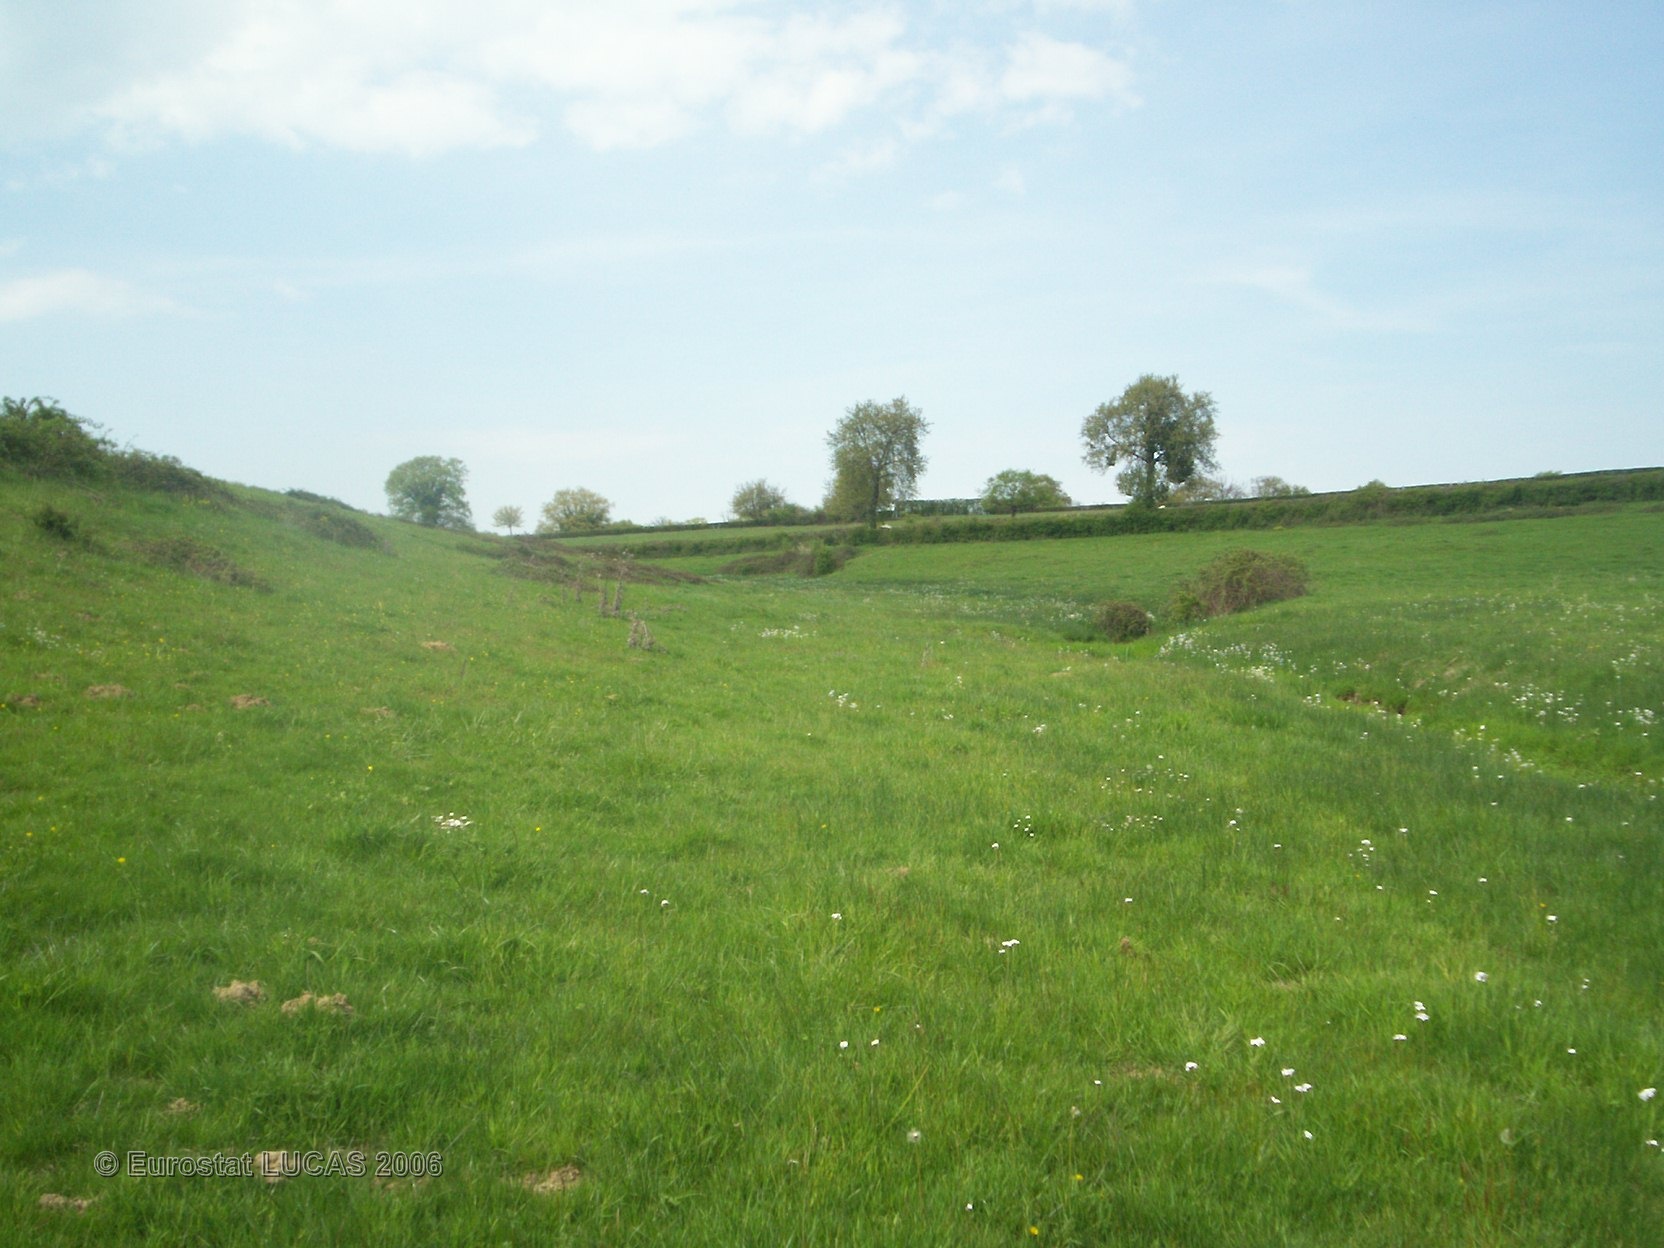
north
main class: Grassland
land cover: Grassland without tree/shrub cover
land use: Agriculture (excluding fallow land and kitchen gardens)
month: May
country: FR
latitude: 46.4022
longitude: 3.1433
